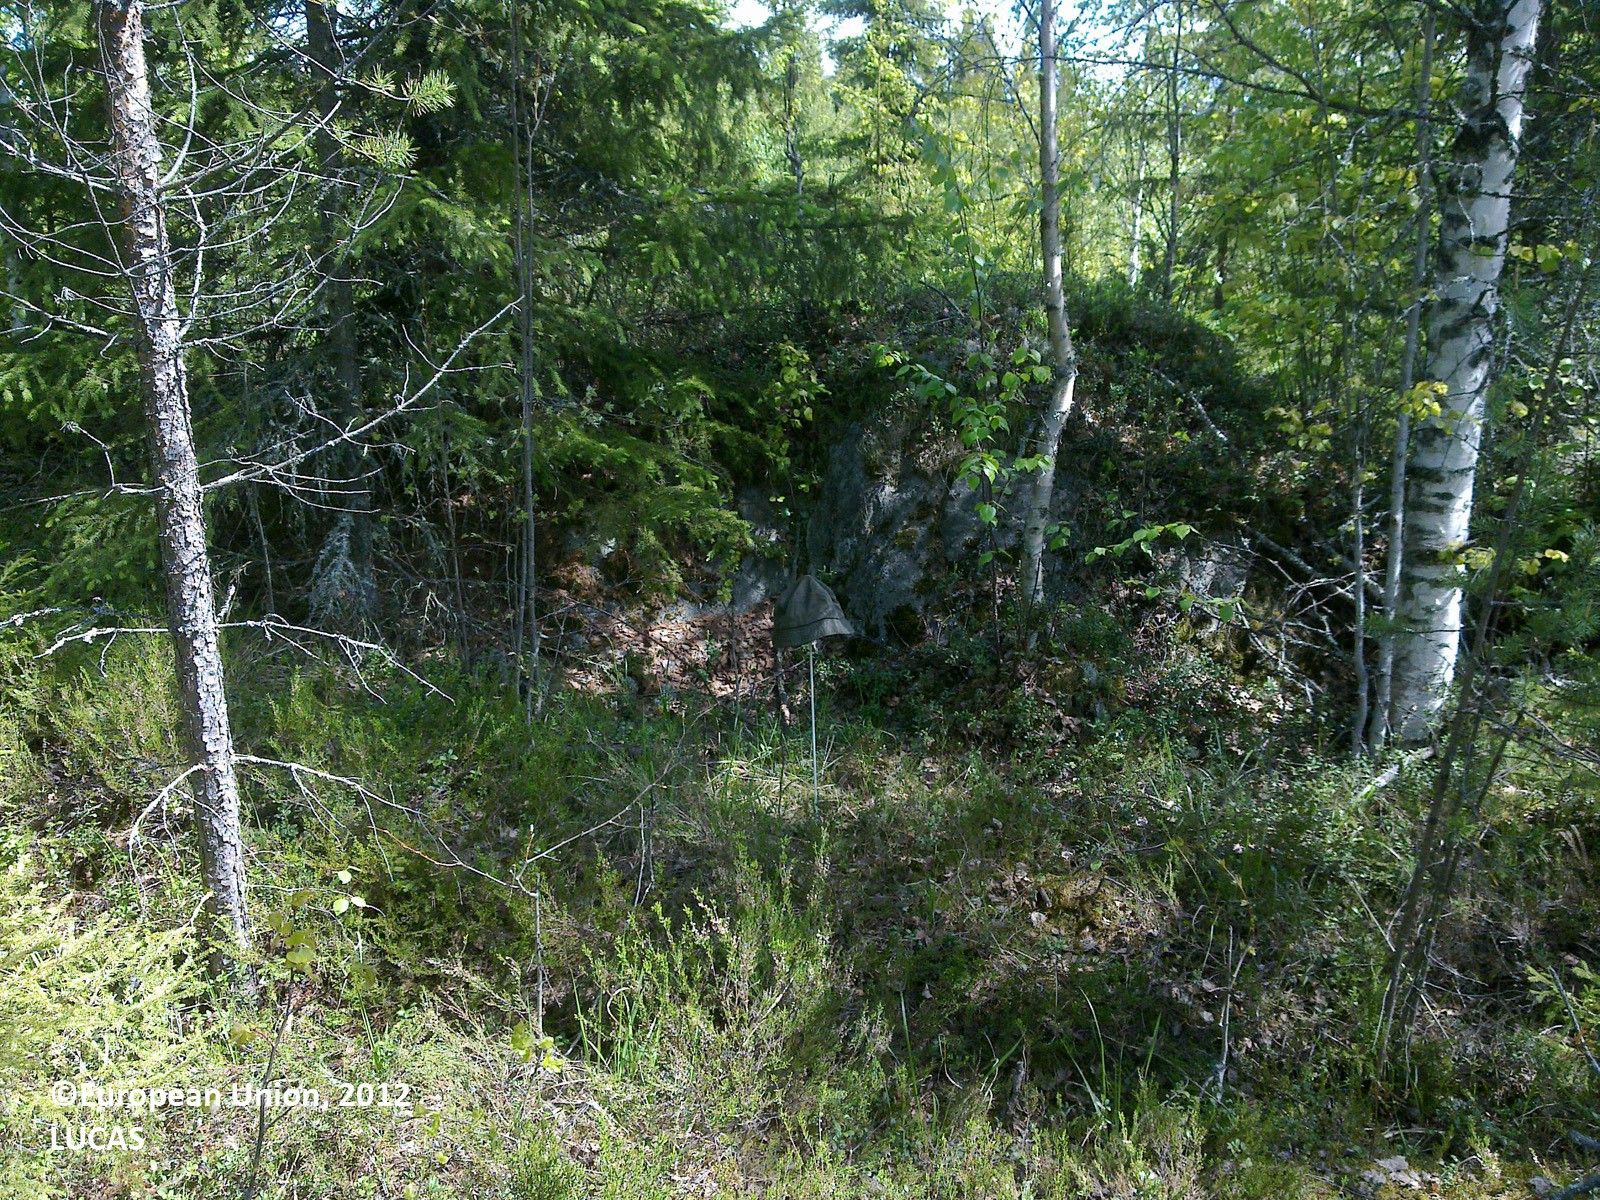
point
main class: Woodland
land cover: Other mixed woodland
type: boreal forest
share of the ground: > 75 %
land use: Forestry
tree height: > 5 m
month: June
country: FI
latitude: 62.5762
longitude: 30.5437
